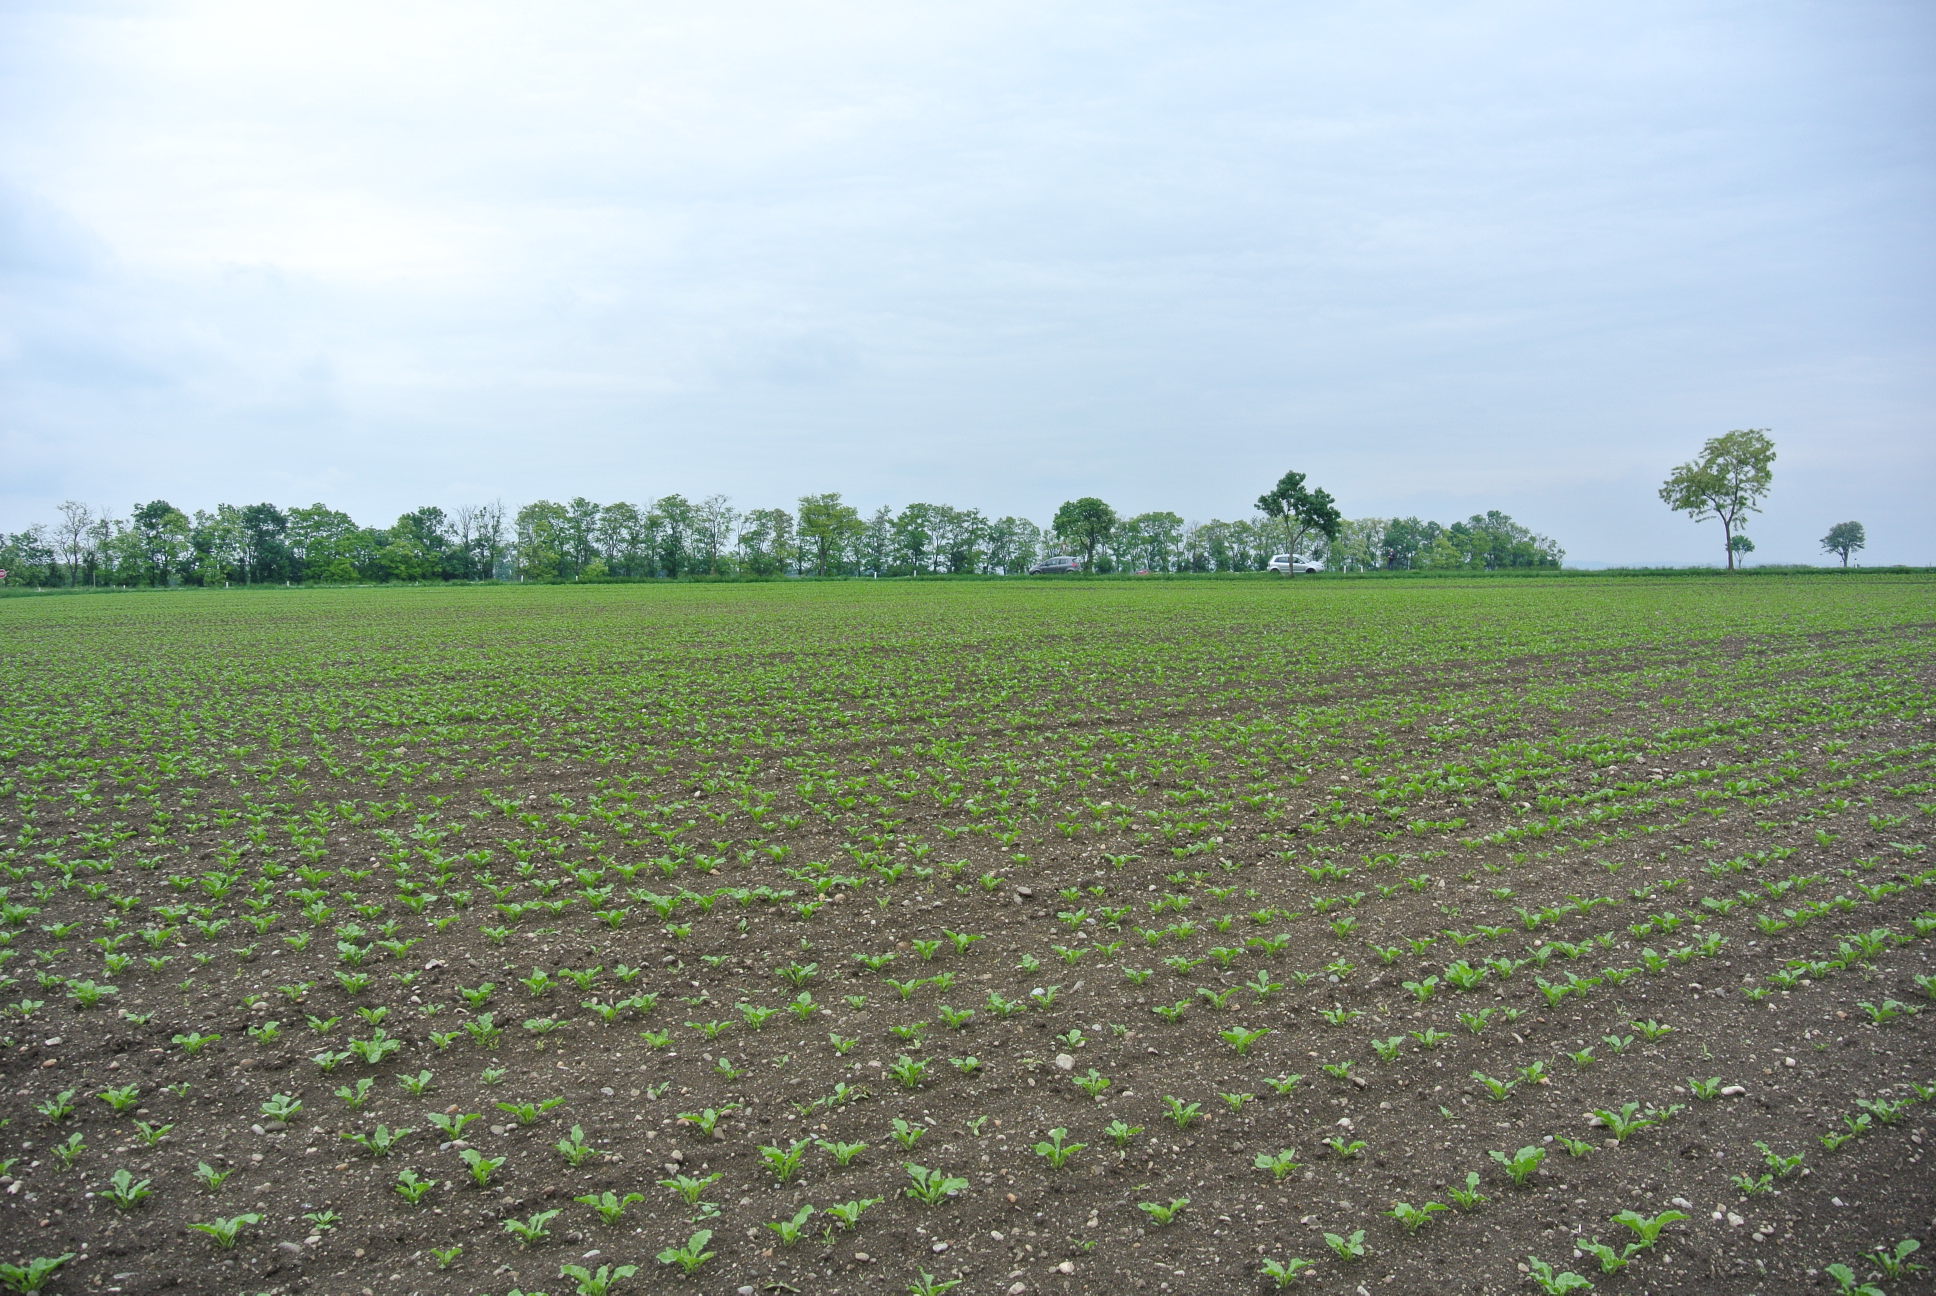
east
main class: Cropland
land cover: Sugar beet
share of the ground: 10 - 25 %
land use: Agriculture (excluding fallow land and kitchen gardens)
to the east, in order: Sugar beet; Grass margins; Paved roads, cycling and walking lanes; Grass margins; Sunflower; Grass margins; Paved roads, cycling and walking lanes; Broadleaved woodland; Common wheat
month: May
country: AT
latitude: 48.0522
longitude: 16.4581
